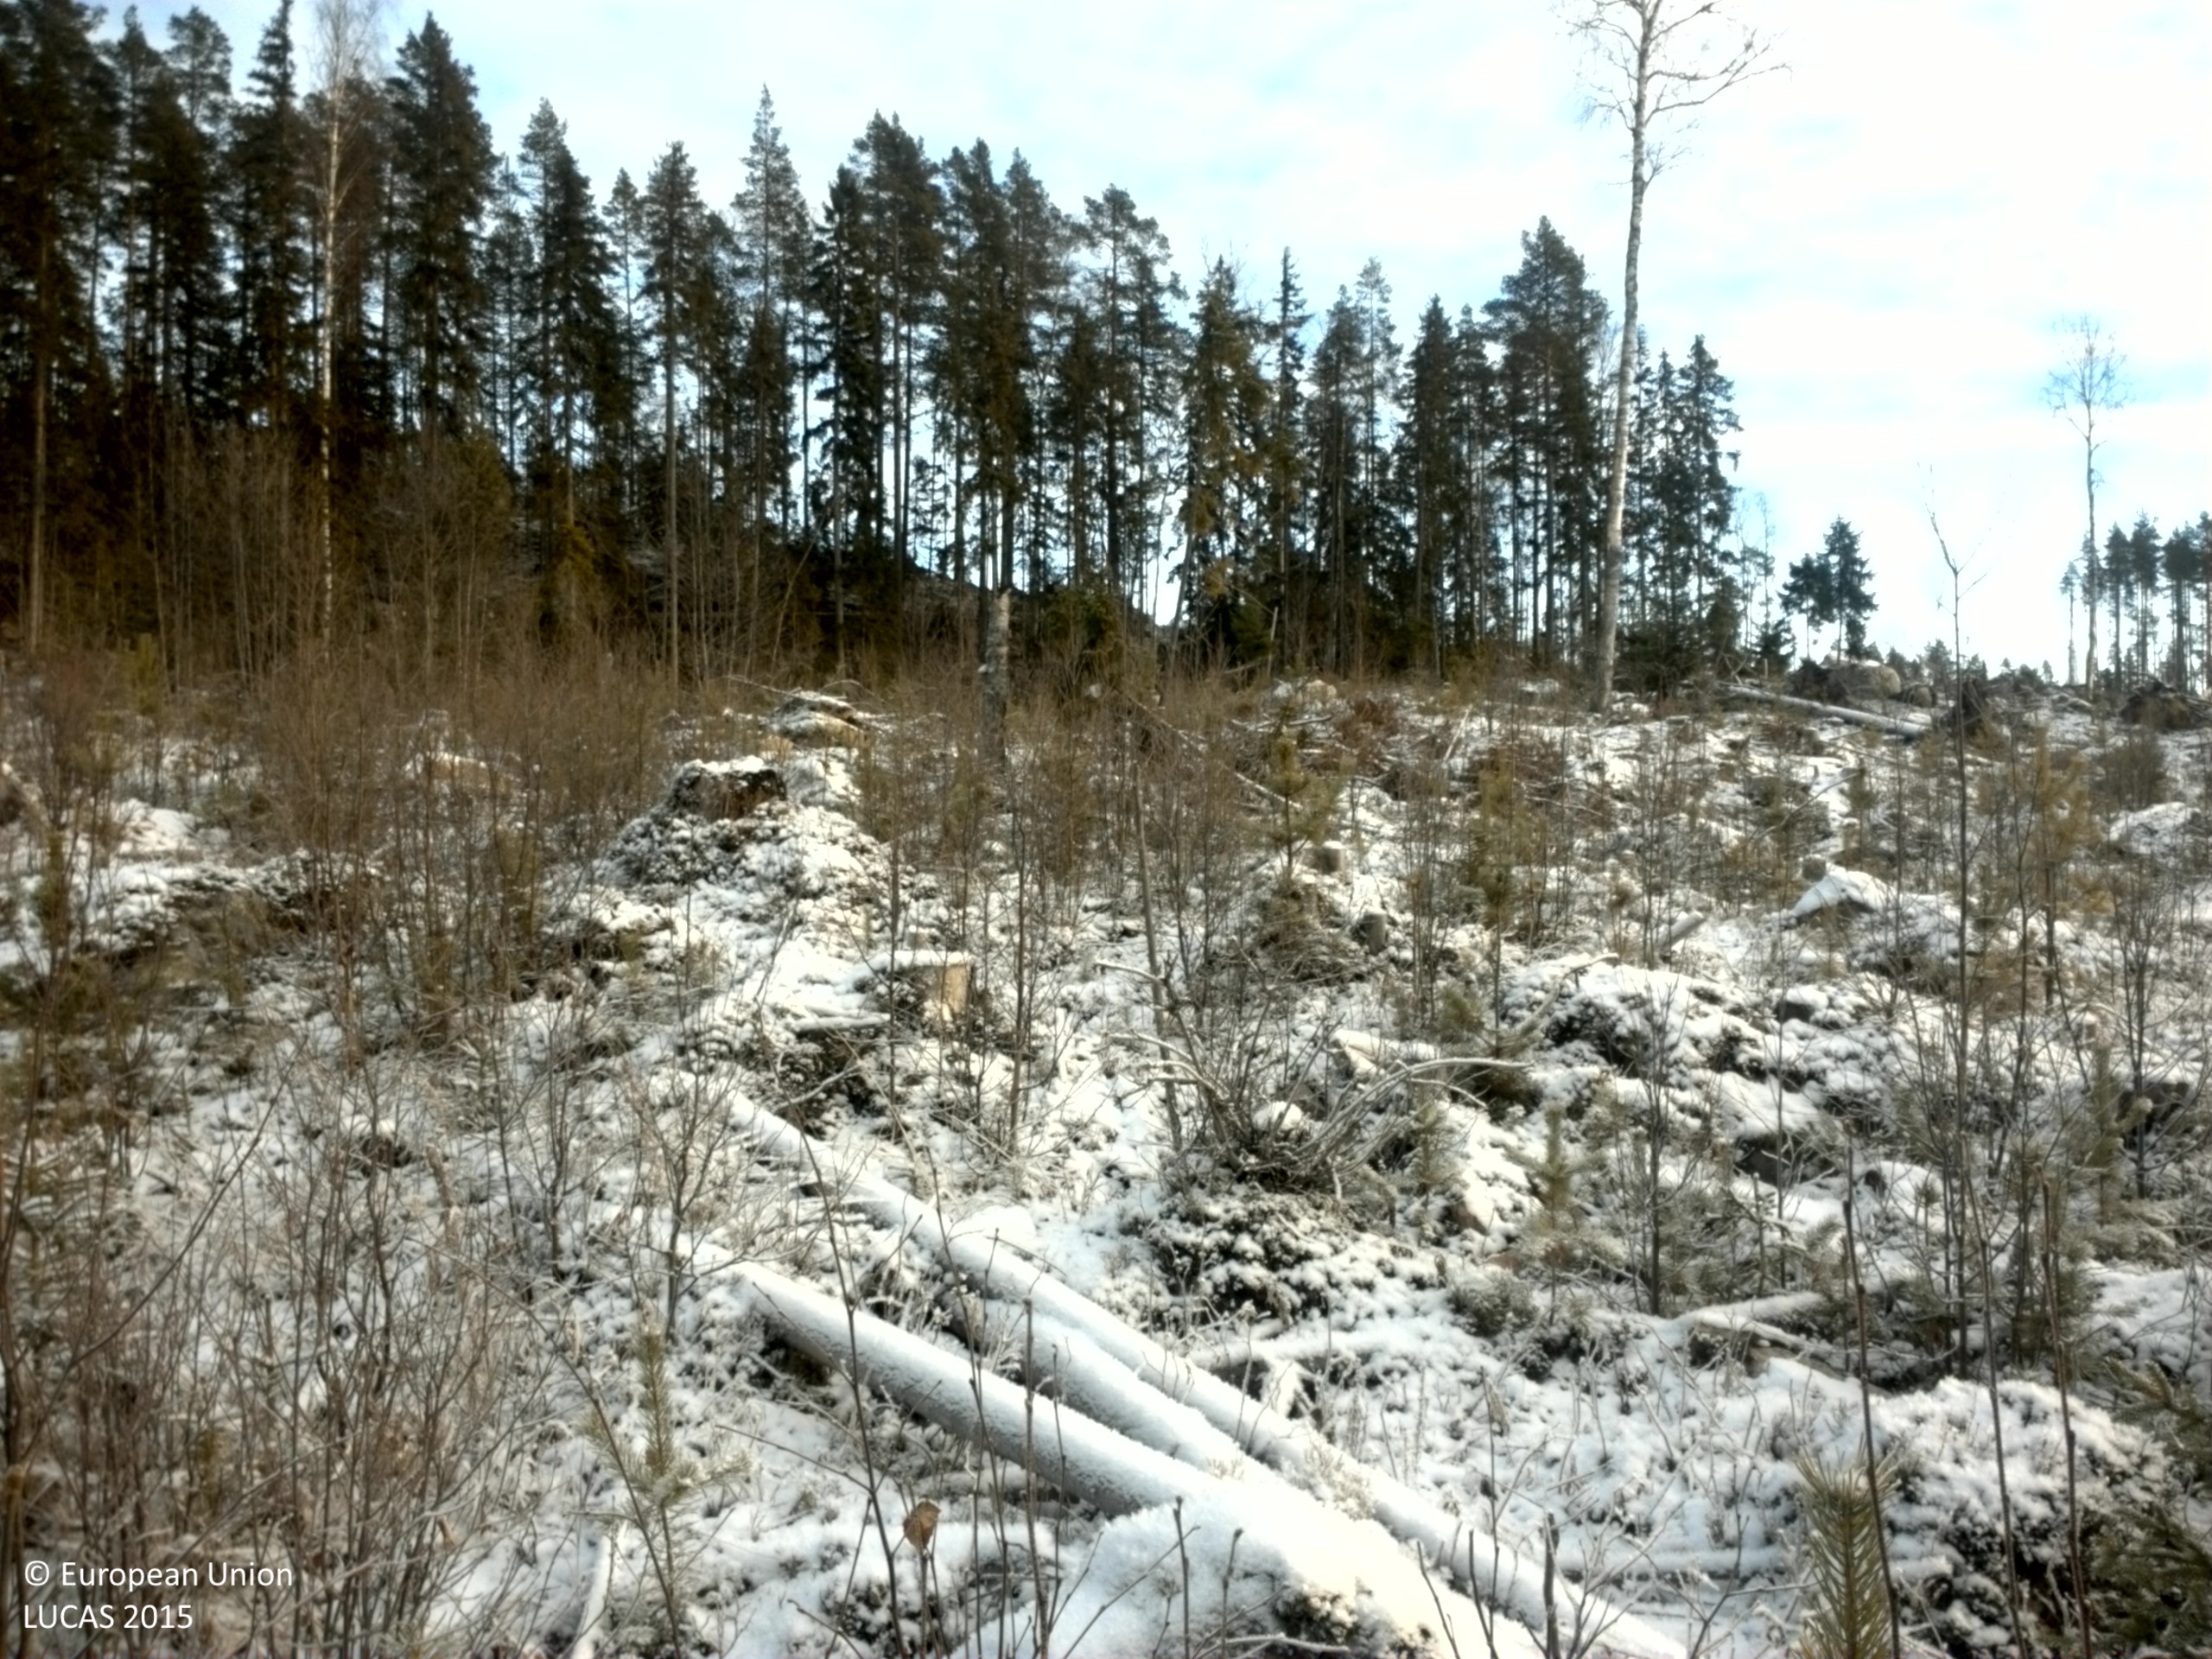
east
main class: Woodland
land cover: Other mixed woodland
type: boreal forest
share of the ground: 25 - 50 %
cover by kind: shrubs 40 %, lichens and mosses 25 %, broadleaved forest trees 20 %, coniferous forest trees 15 %
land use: Forestry
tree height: < 5 m
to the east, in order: Other mixed woodland; Other coniferous woodland; Rocks and stones; Pine dominated coniferous woodland; Other mixed woodland; Pine dominated coniferous woodland
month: November
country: SE
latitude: 62.0127
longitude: 15.3114
